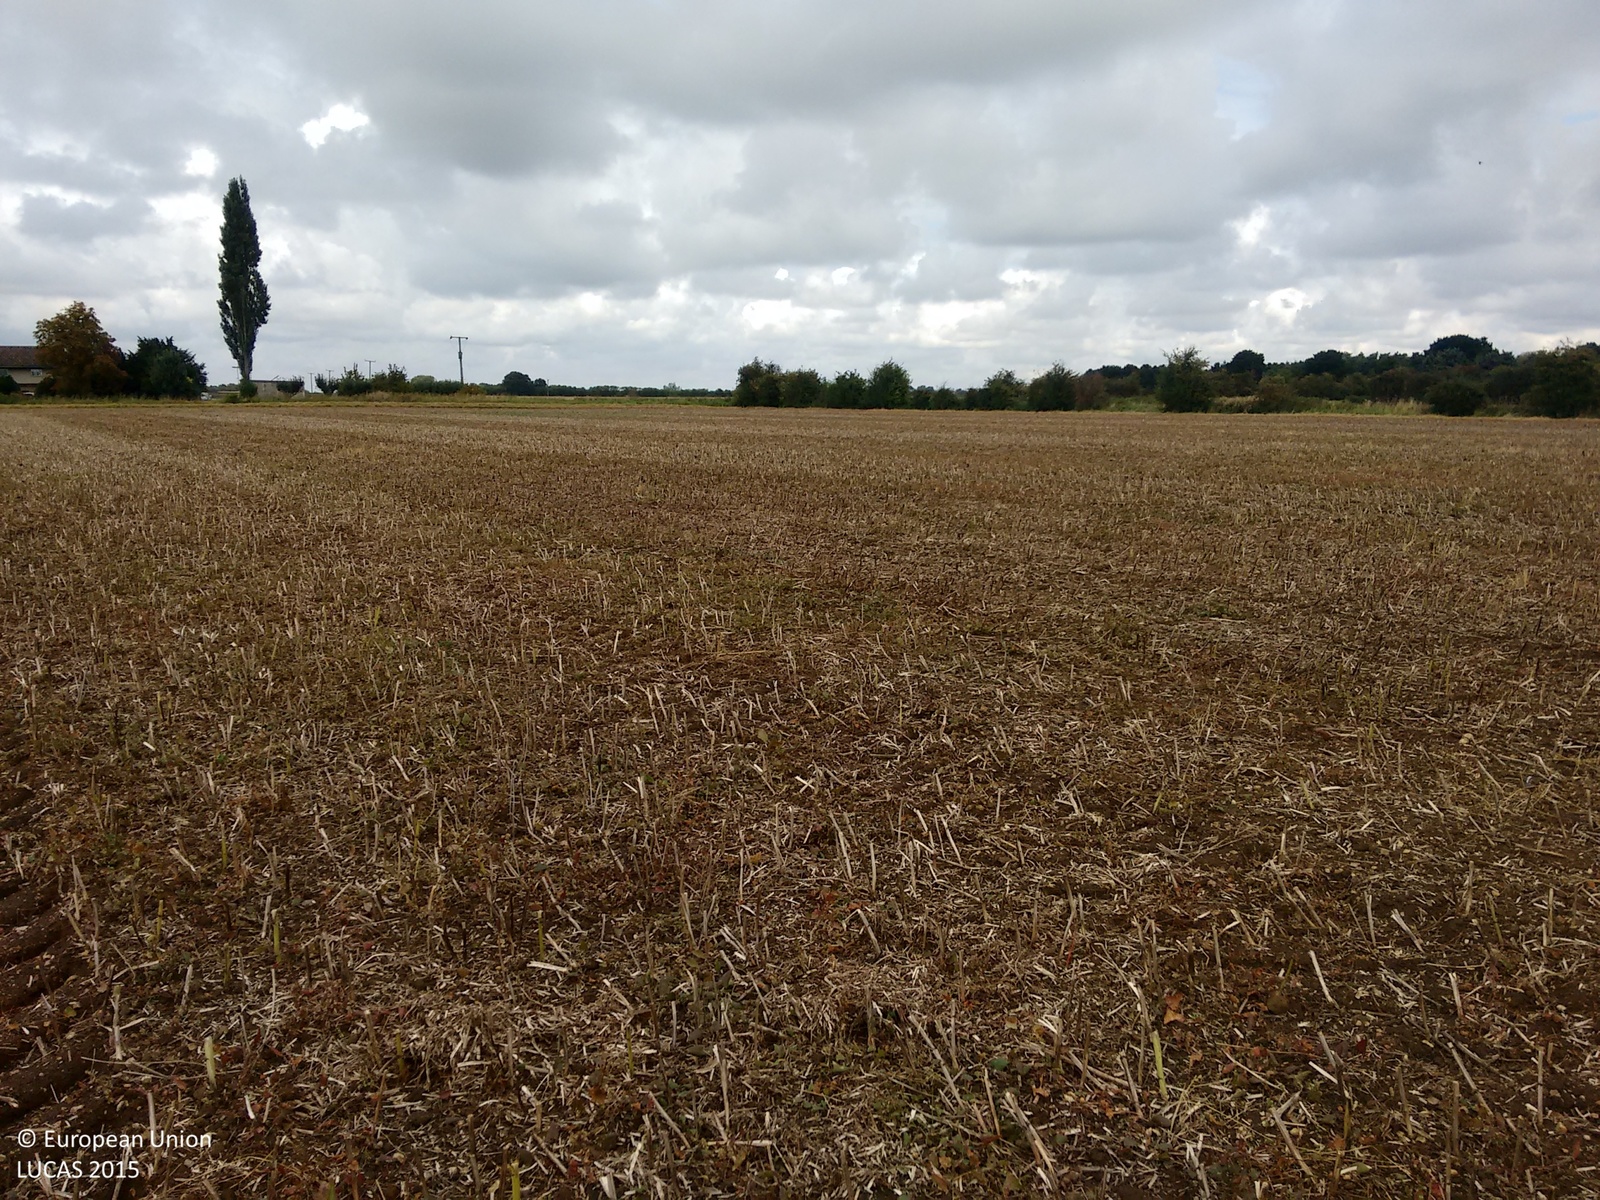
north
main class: Cropland
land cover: Dry pulses
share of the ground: < 10 %
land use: Agriculture (excluding fallow land and kitchen gardens)
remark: Harvested field
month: September
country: GB
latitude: 52.2938
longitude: 0.1600
